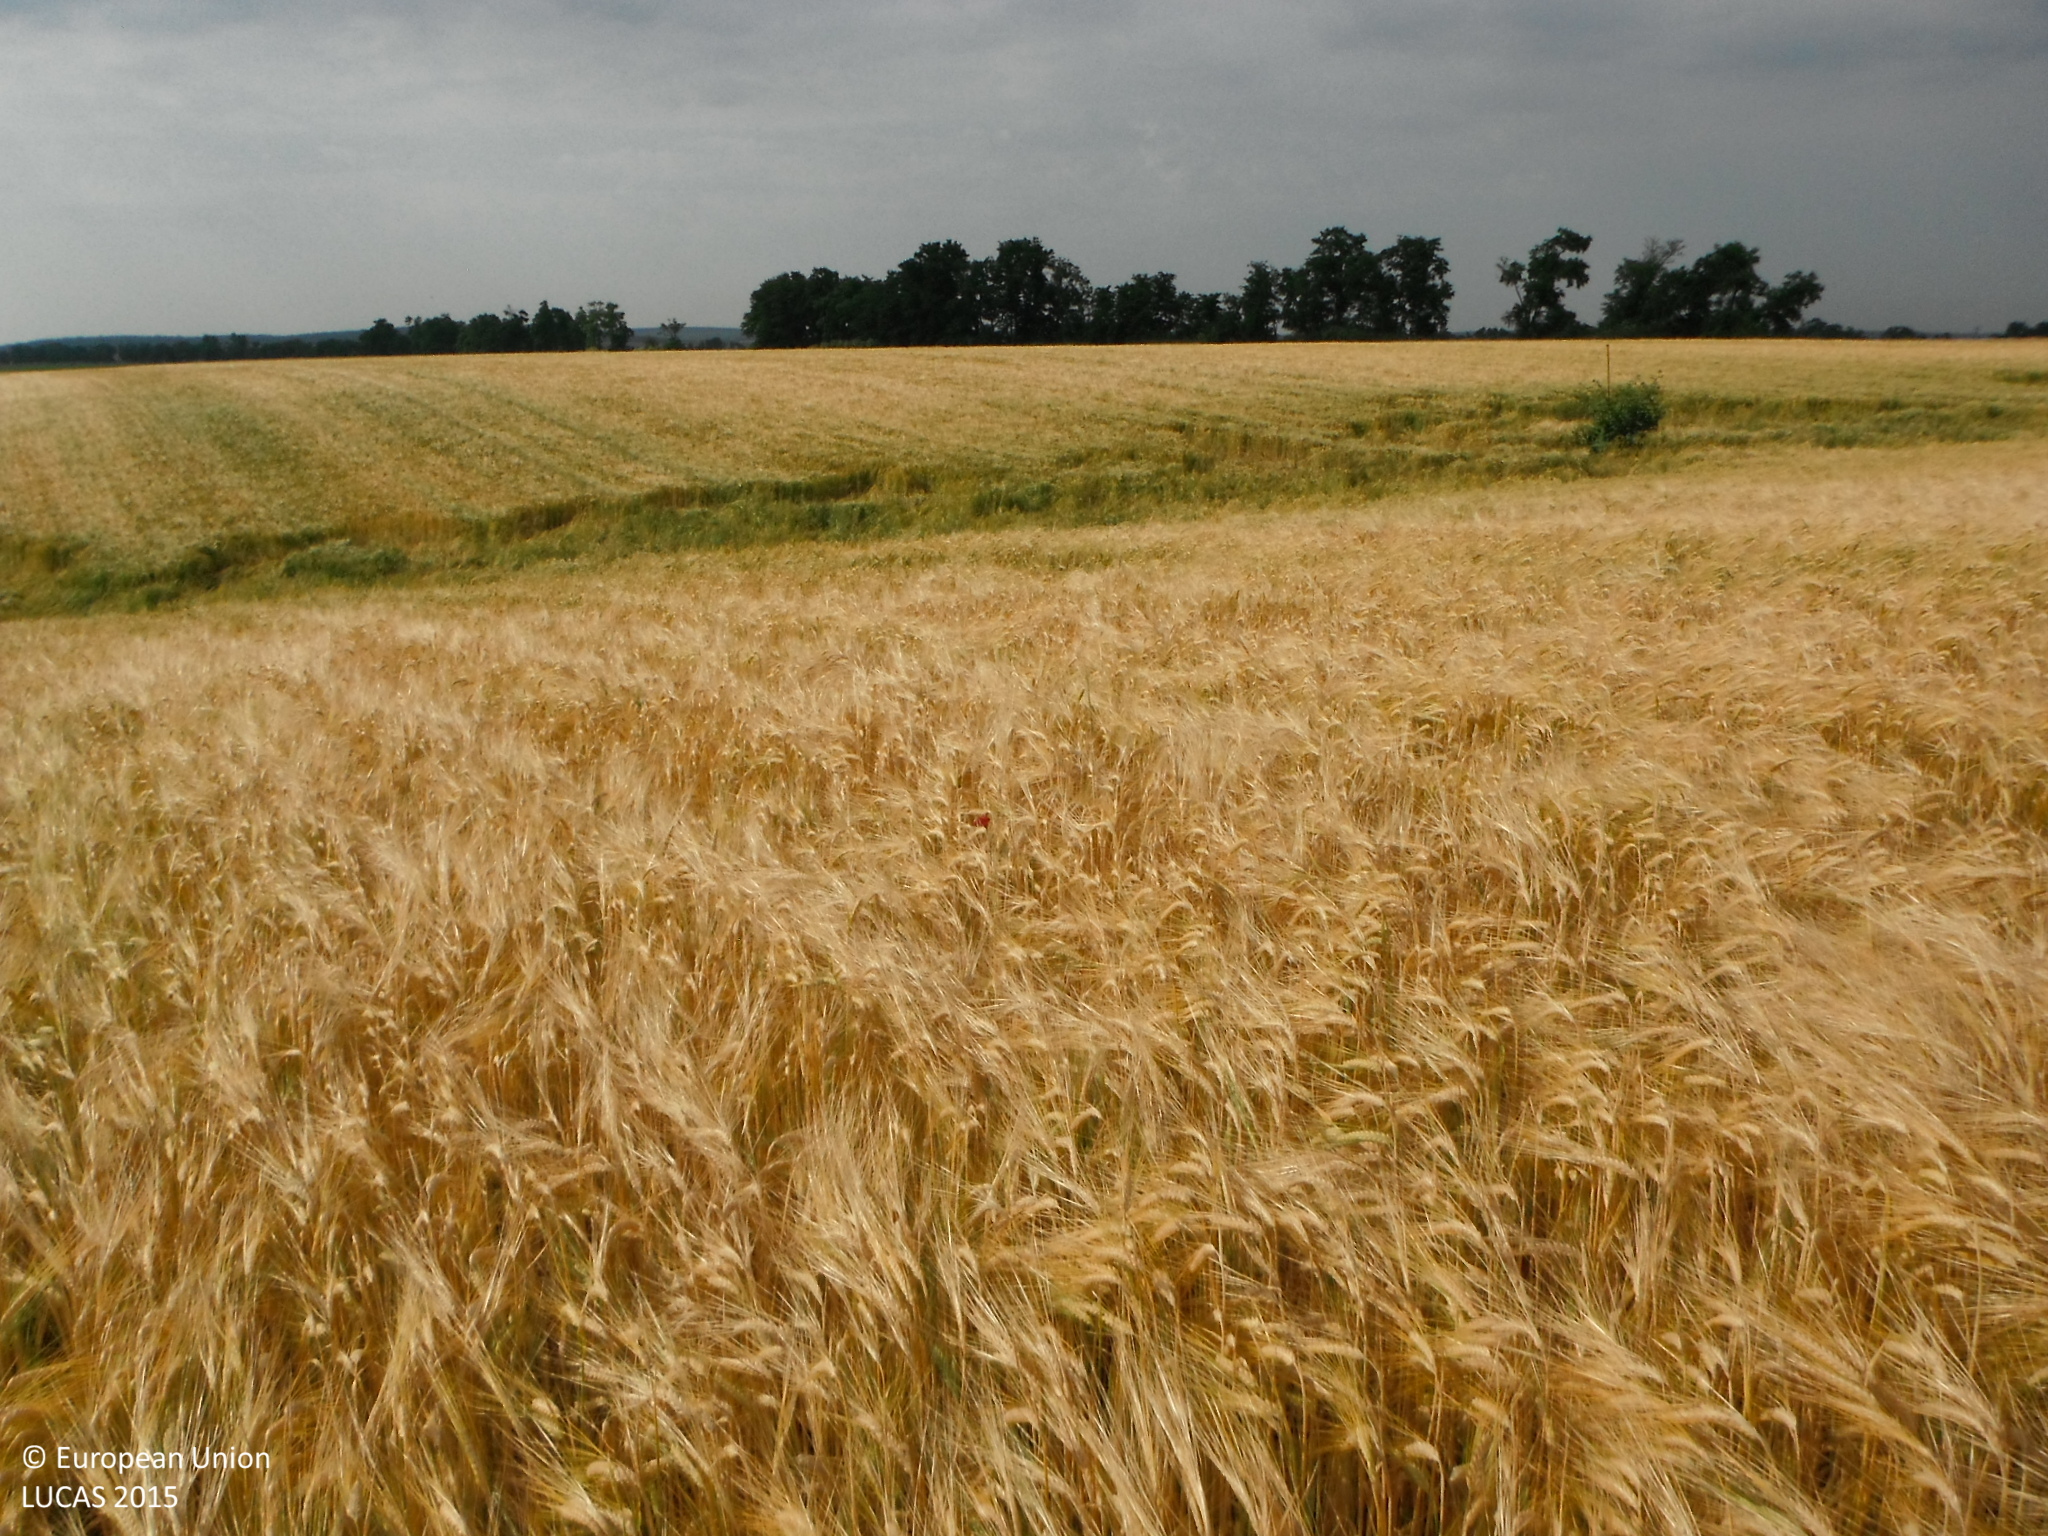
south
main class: Cropland
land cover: Barley
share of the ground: > 75 %
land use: Agriculture (excluding fallow land and kitchen gardens)
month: July
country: SK
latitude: 48.4048
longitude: 17.9696
